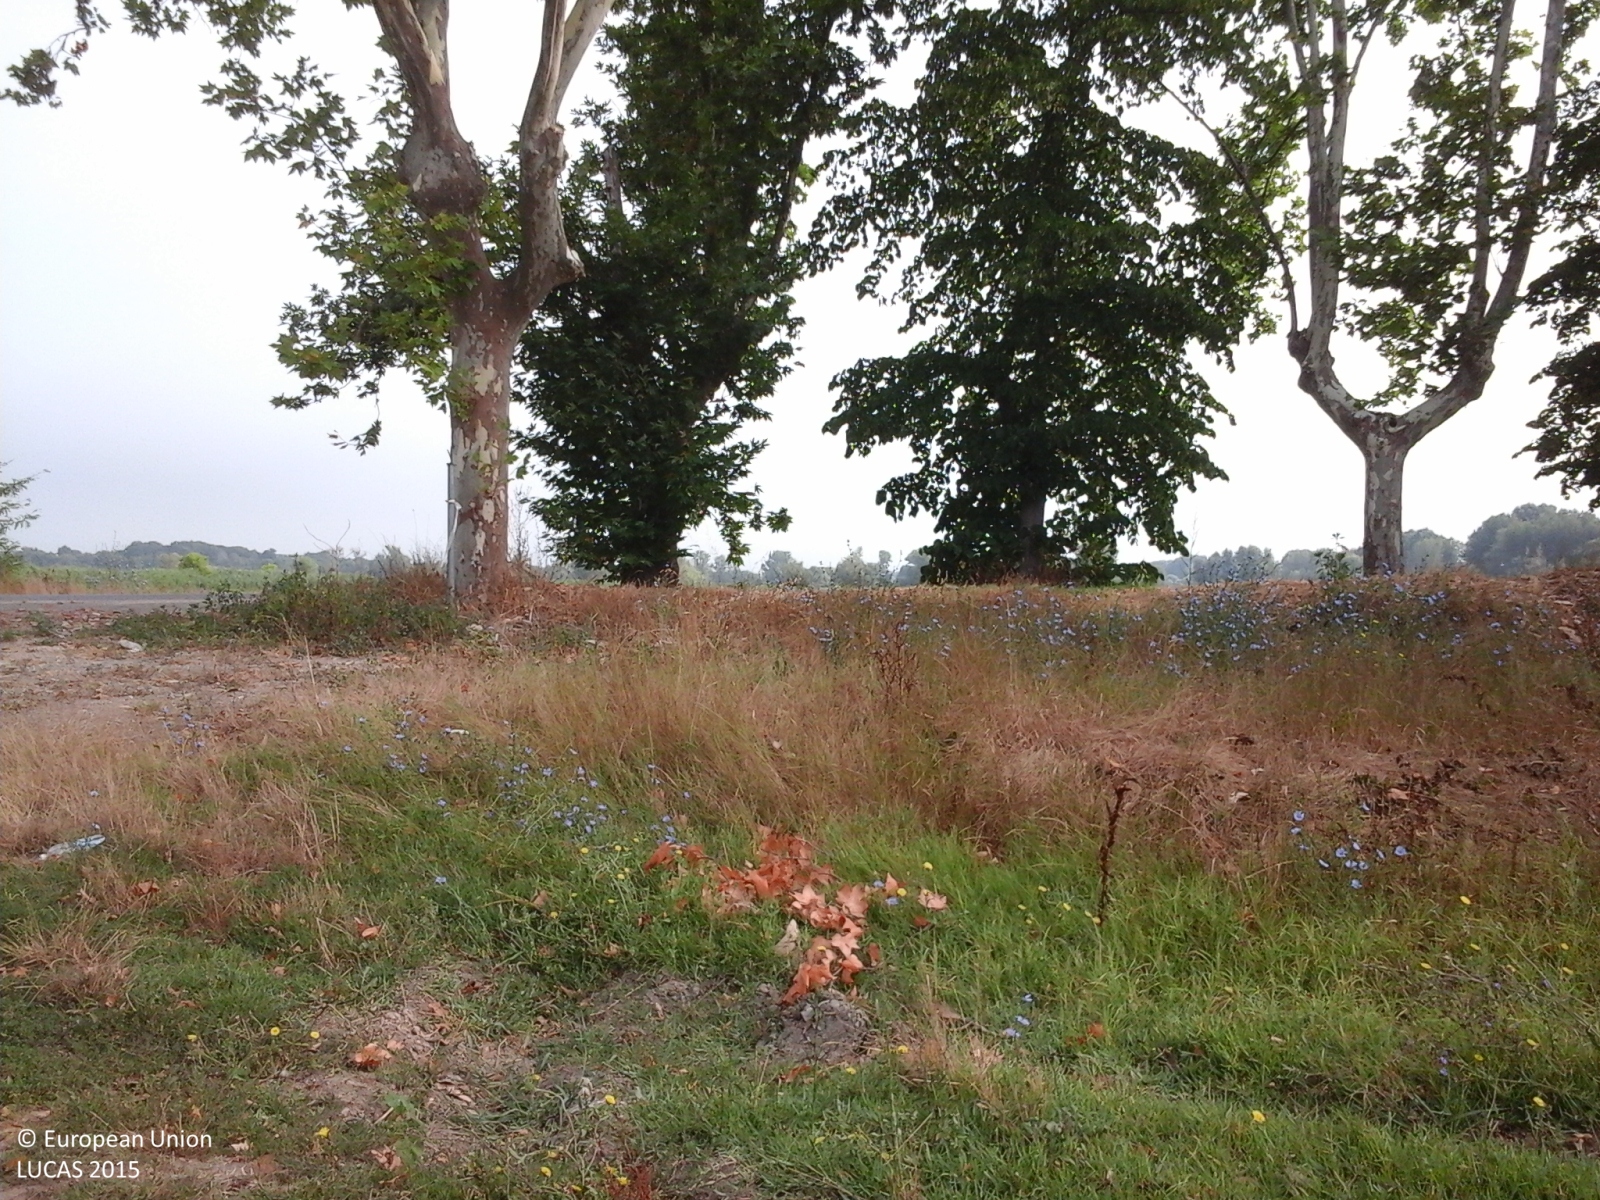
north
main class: Grassland
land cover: Grassland without tree/shrub cover
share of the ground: > 75 %
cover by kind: herbaceous plants 95 %, shrubs 5 %
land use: Agriculture (excluding fallow land and kitchen gardens)
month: July
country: IT
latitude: 43.7533
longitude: 10.6317
